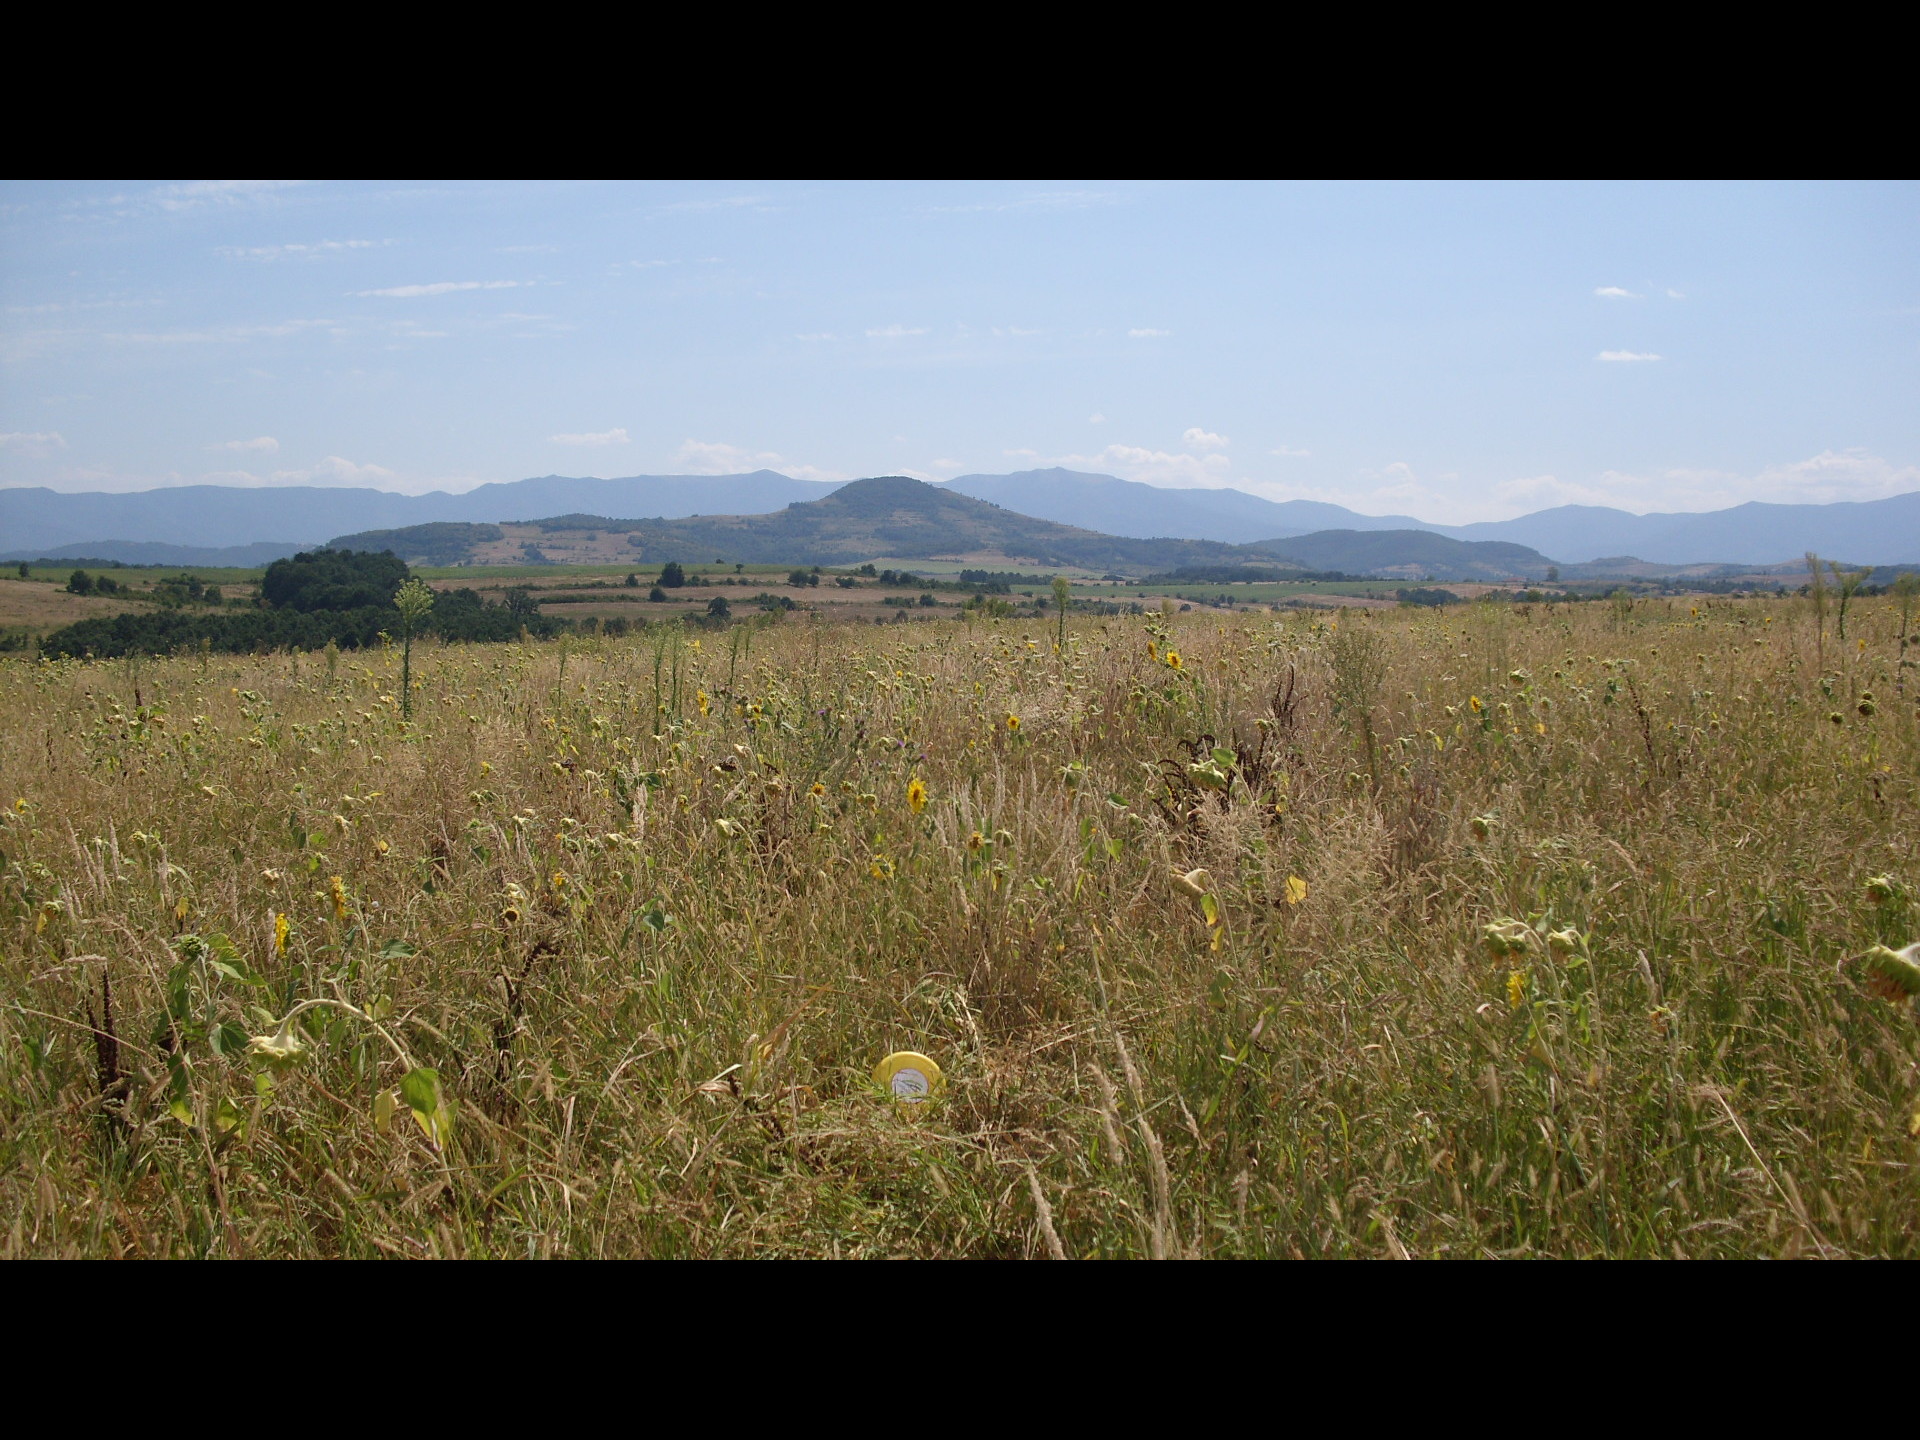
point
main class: Grassland
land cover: Spontaneously vegetated surfaces
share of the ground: > 75 %
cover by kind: herbaceous plants 100 %
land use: Agriculture (excluding fallow land and kitchen gardens)
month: August
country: BG
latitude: 43.3116
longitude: 23.2686
